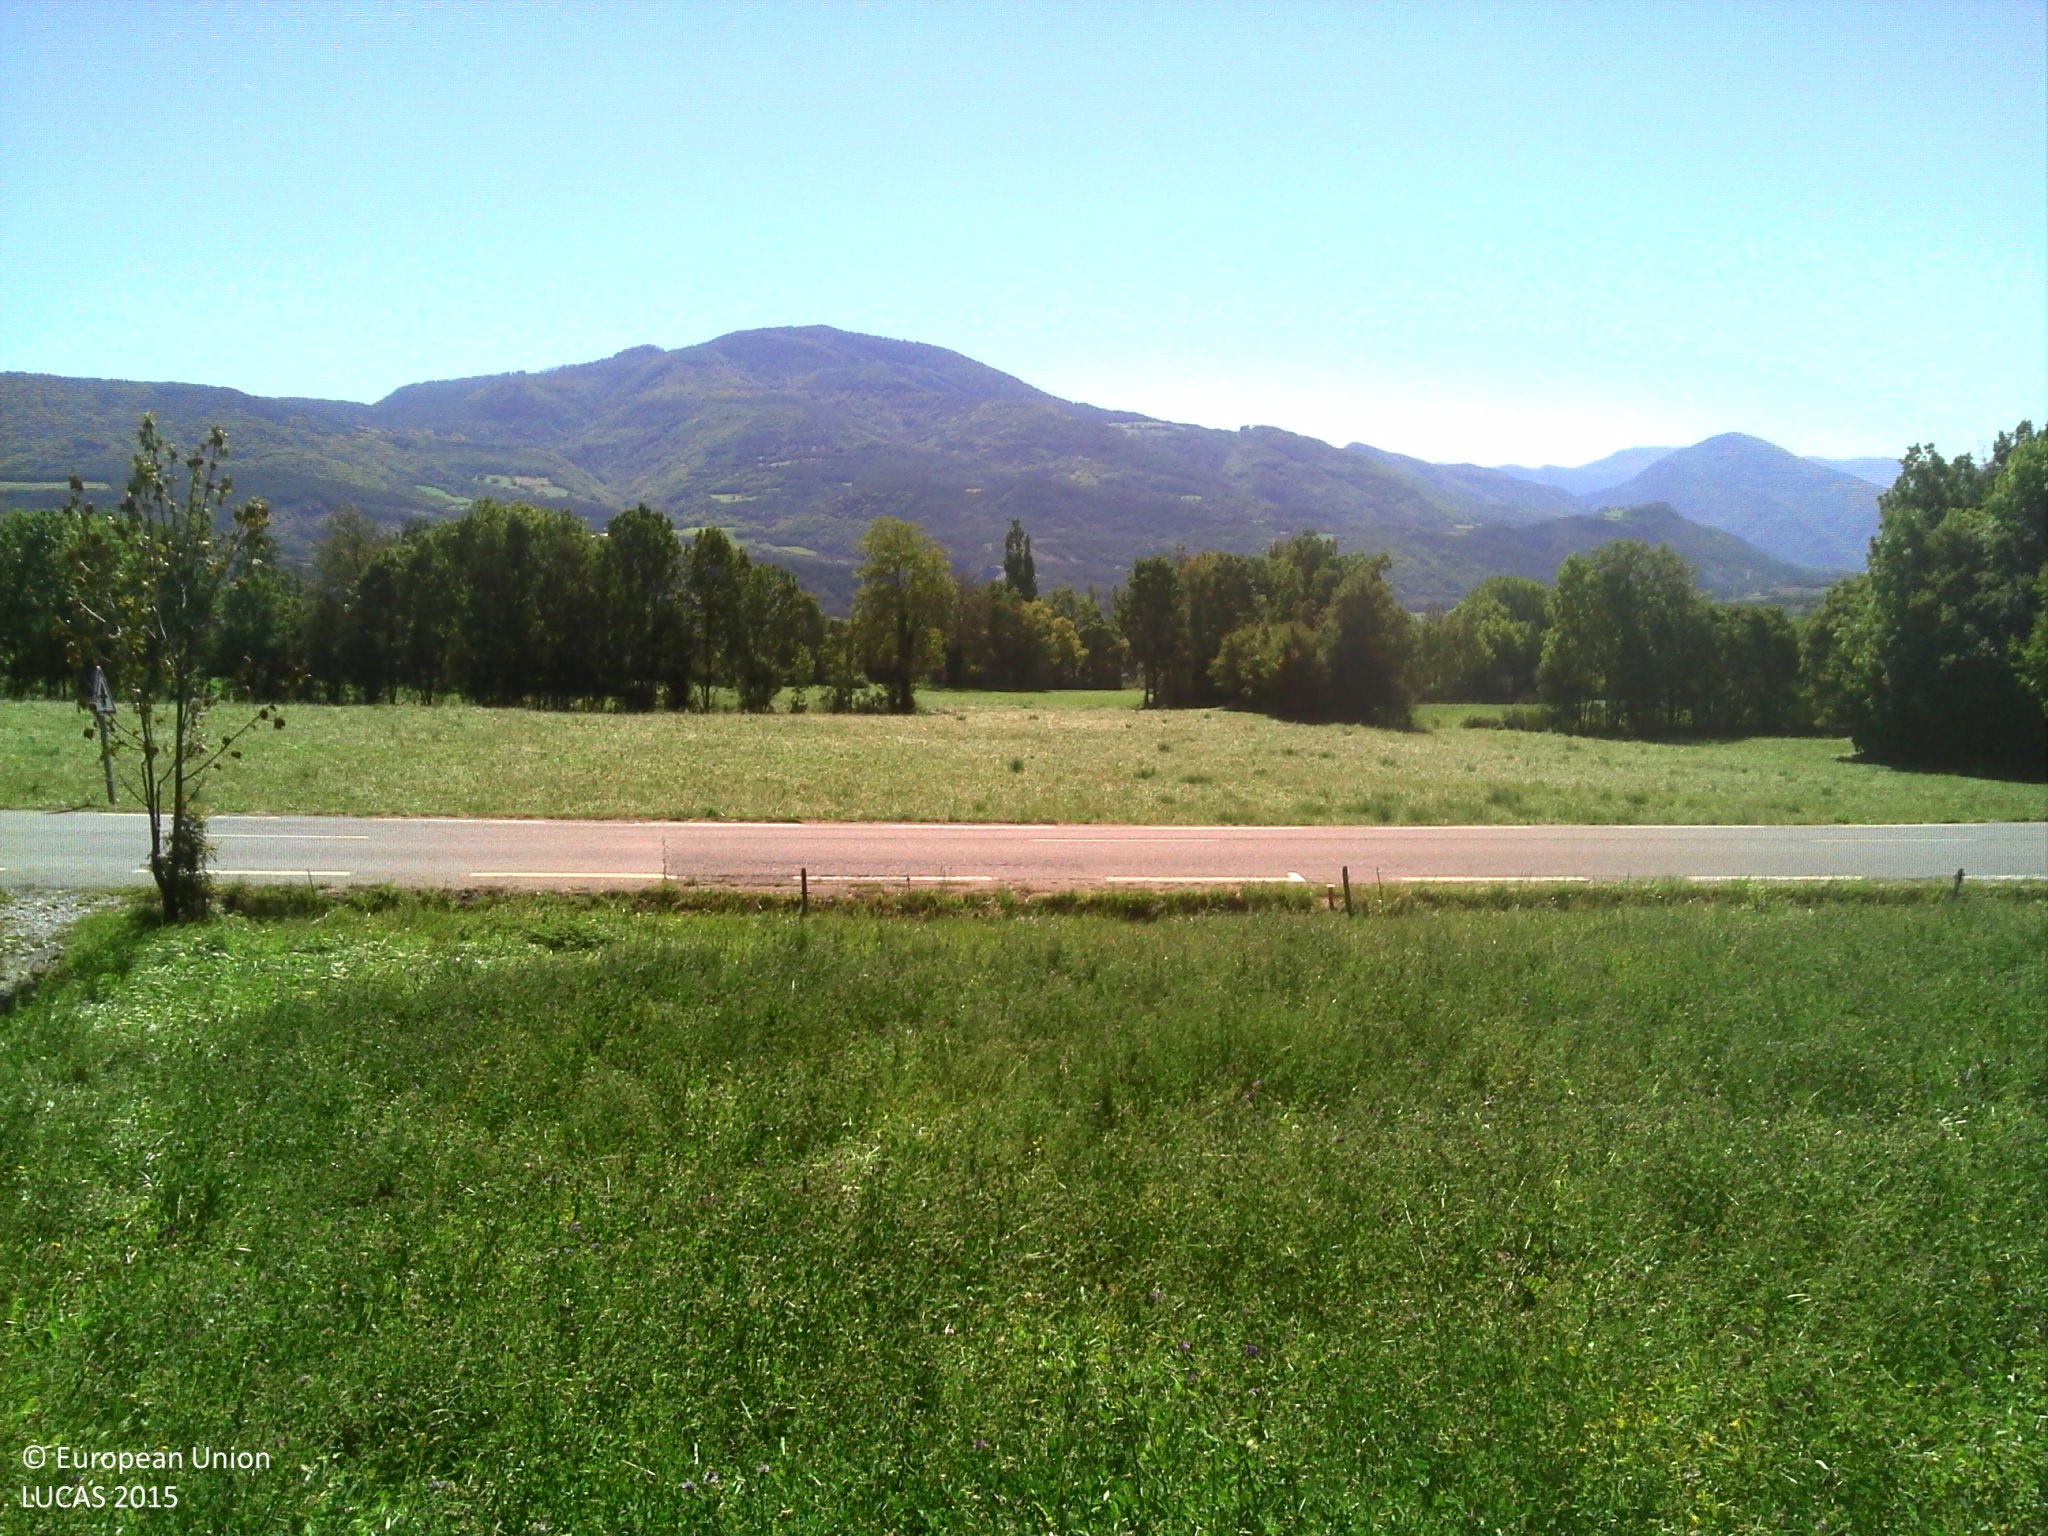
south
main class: Cropland
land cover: Lucerne
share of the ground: > 75 %
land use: Agriculture (excluding fallow land and kitchen gardens)
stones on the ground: < 10 %
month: September
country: FR
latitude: 44.5704
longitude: 6.2163
